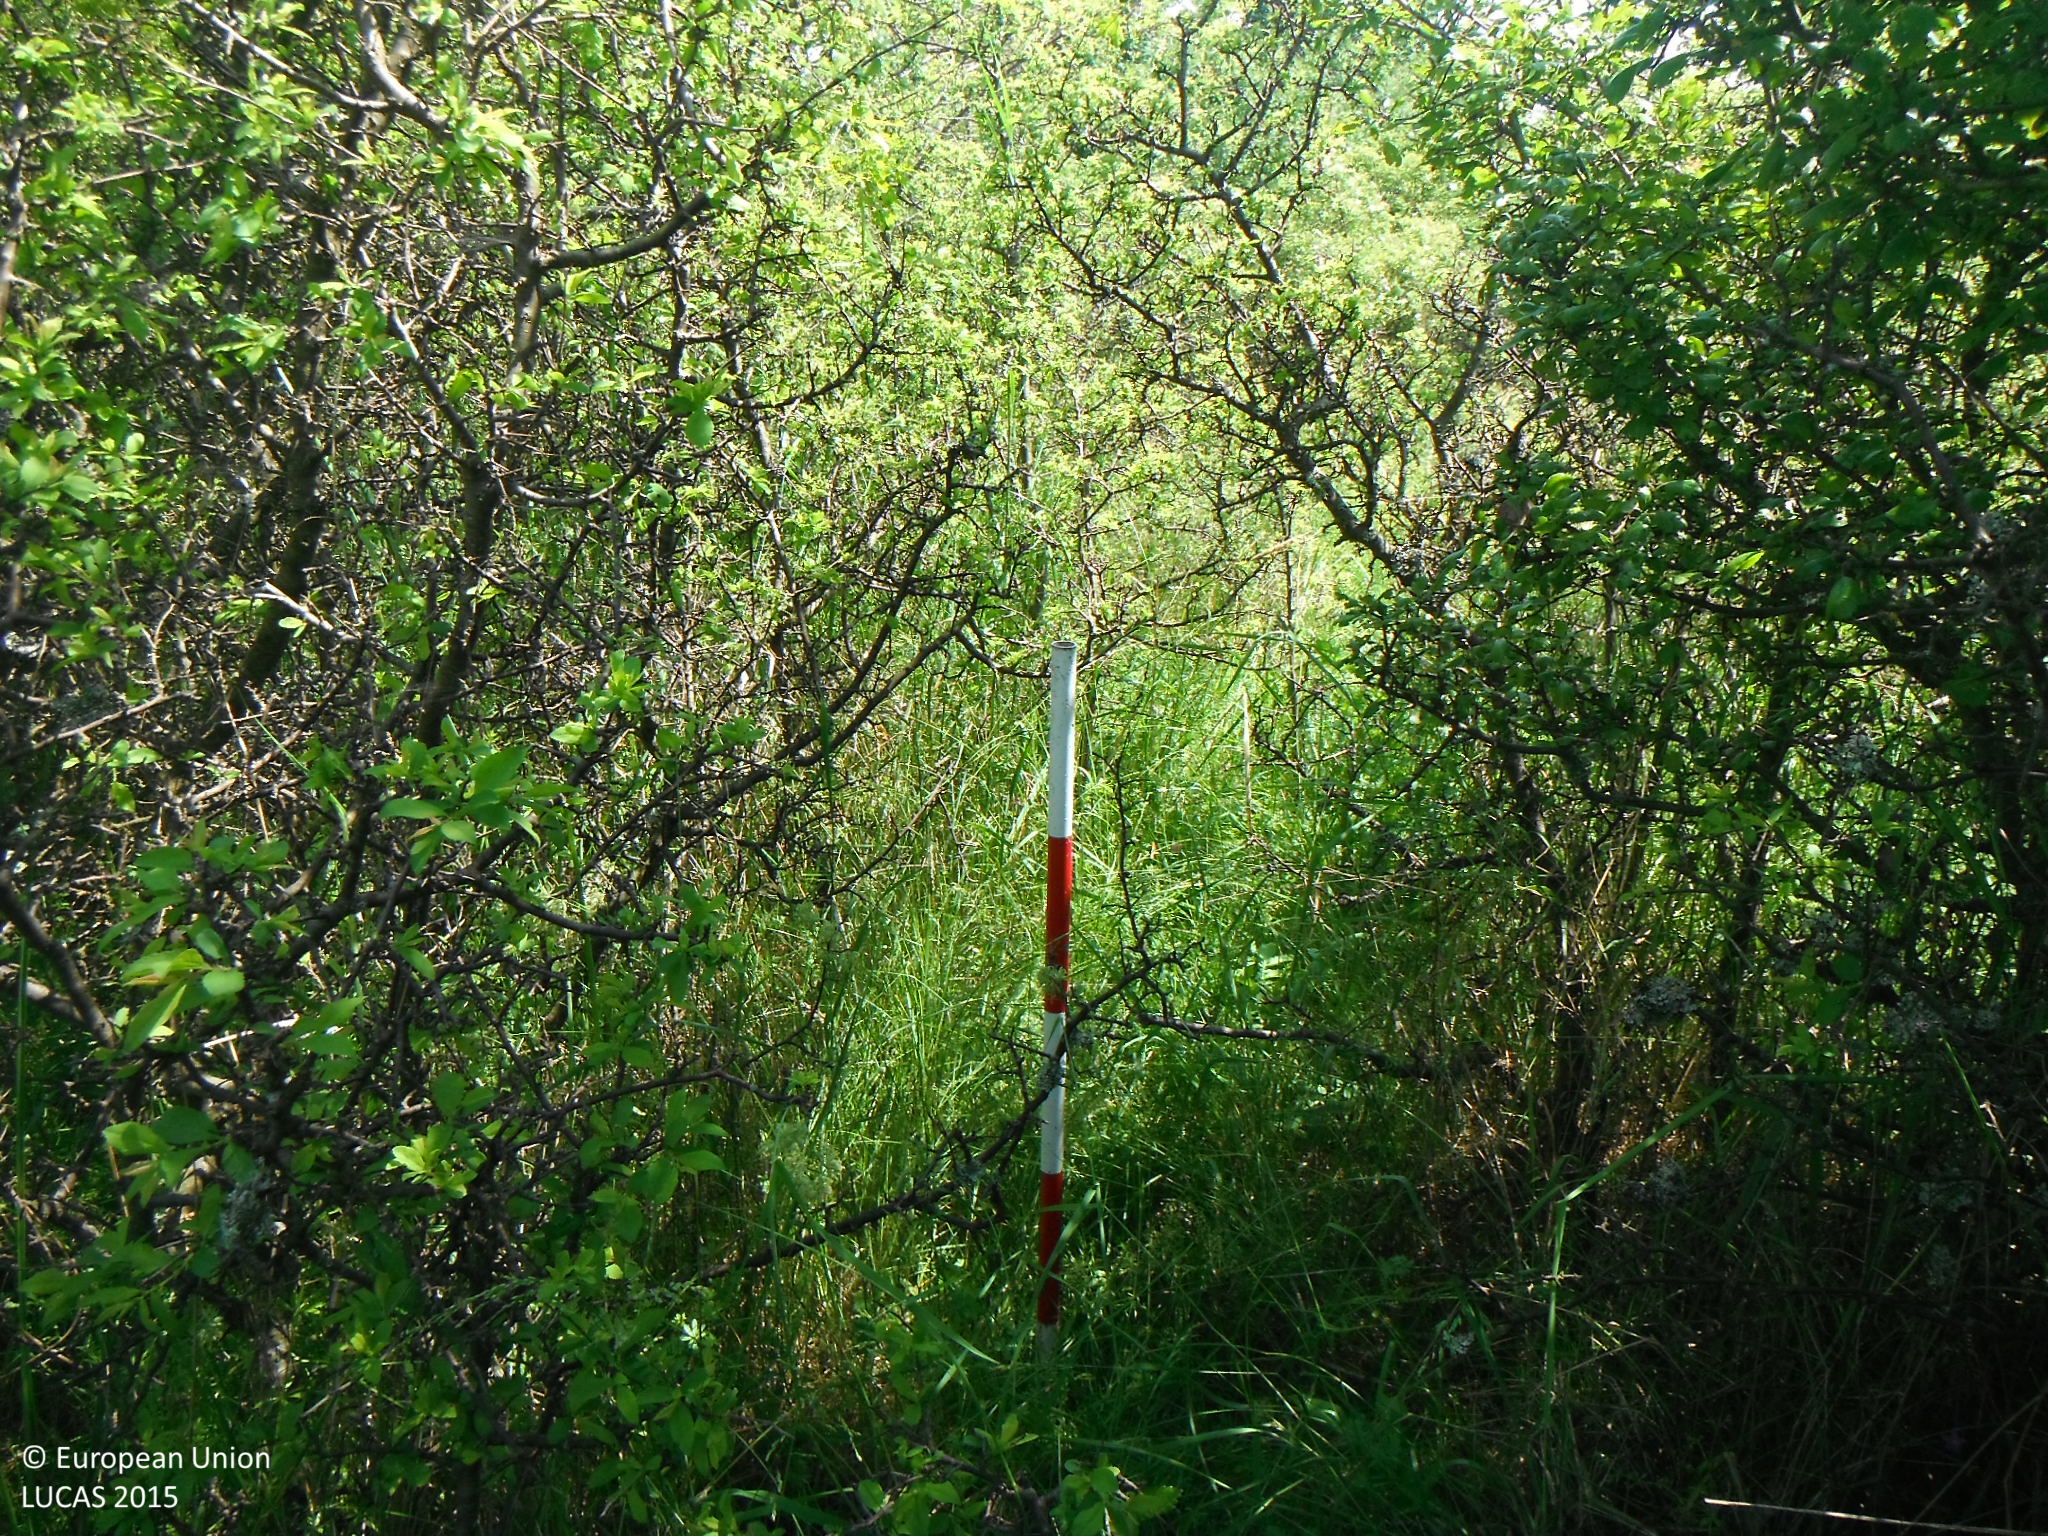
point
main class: Shrubland
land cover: Shrubland with sparse tree cover
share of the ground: > 75 %
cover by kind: shrubs 65 %, herbaceous plants 20 %, broadleaved forest trees 5 %, lichens and mosses 5 %, consolidated bare surface 5 %
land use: Semi-natural and natural areas not in use
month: June
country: SK
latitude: 48.3774
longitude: 19.4615
